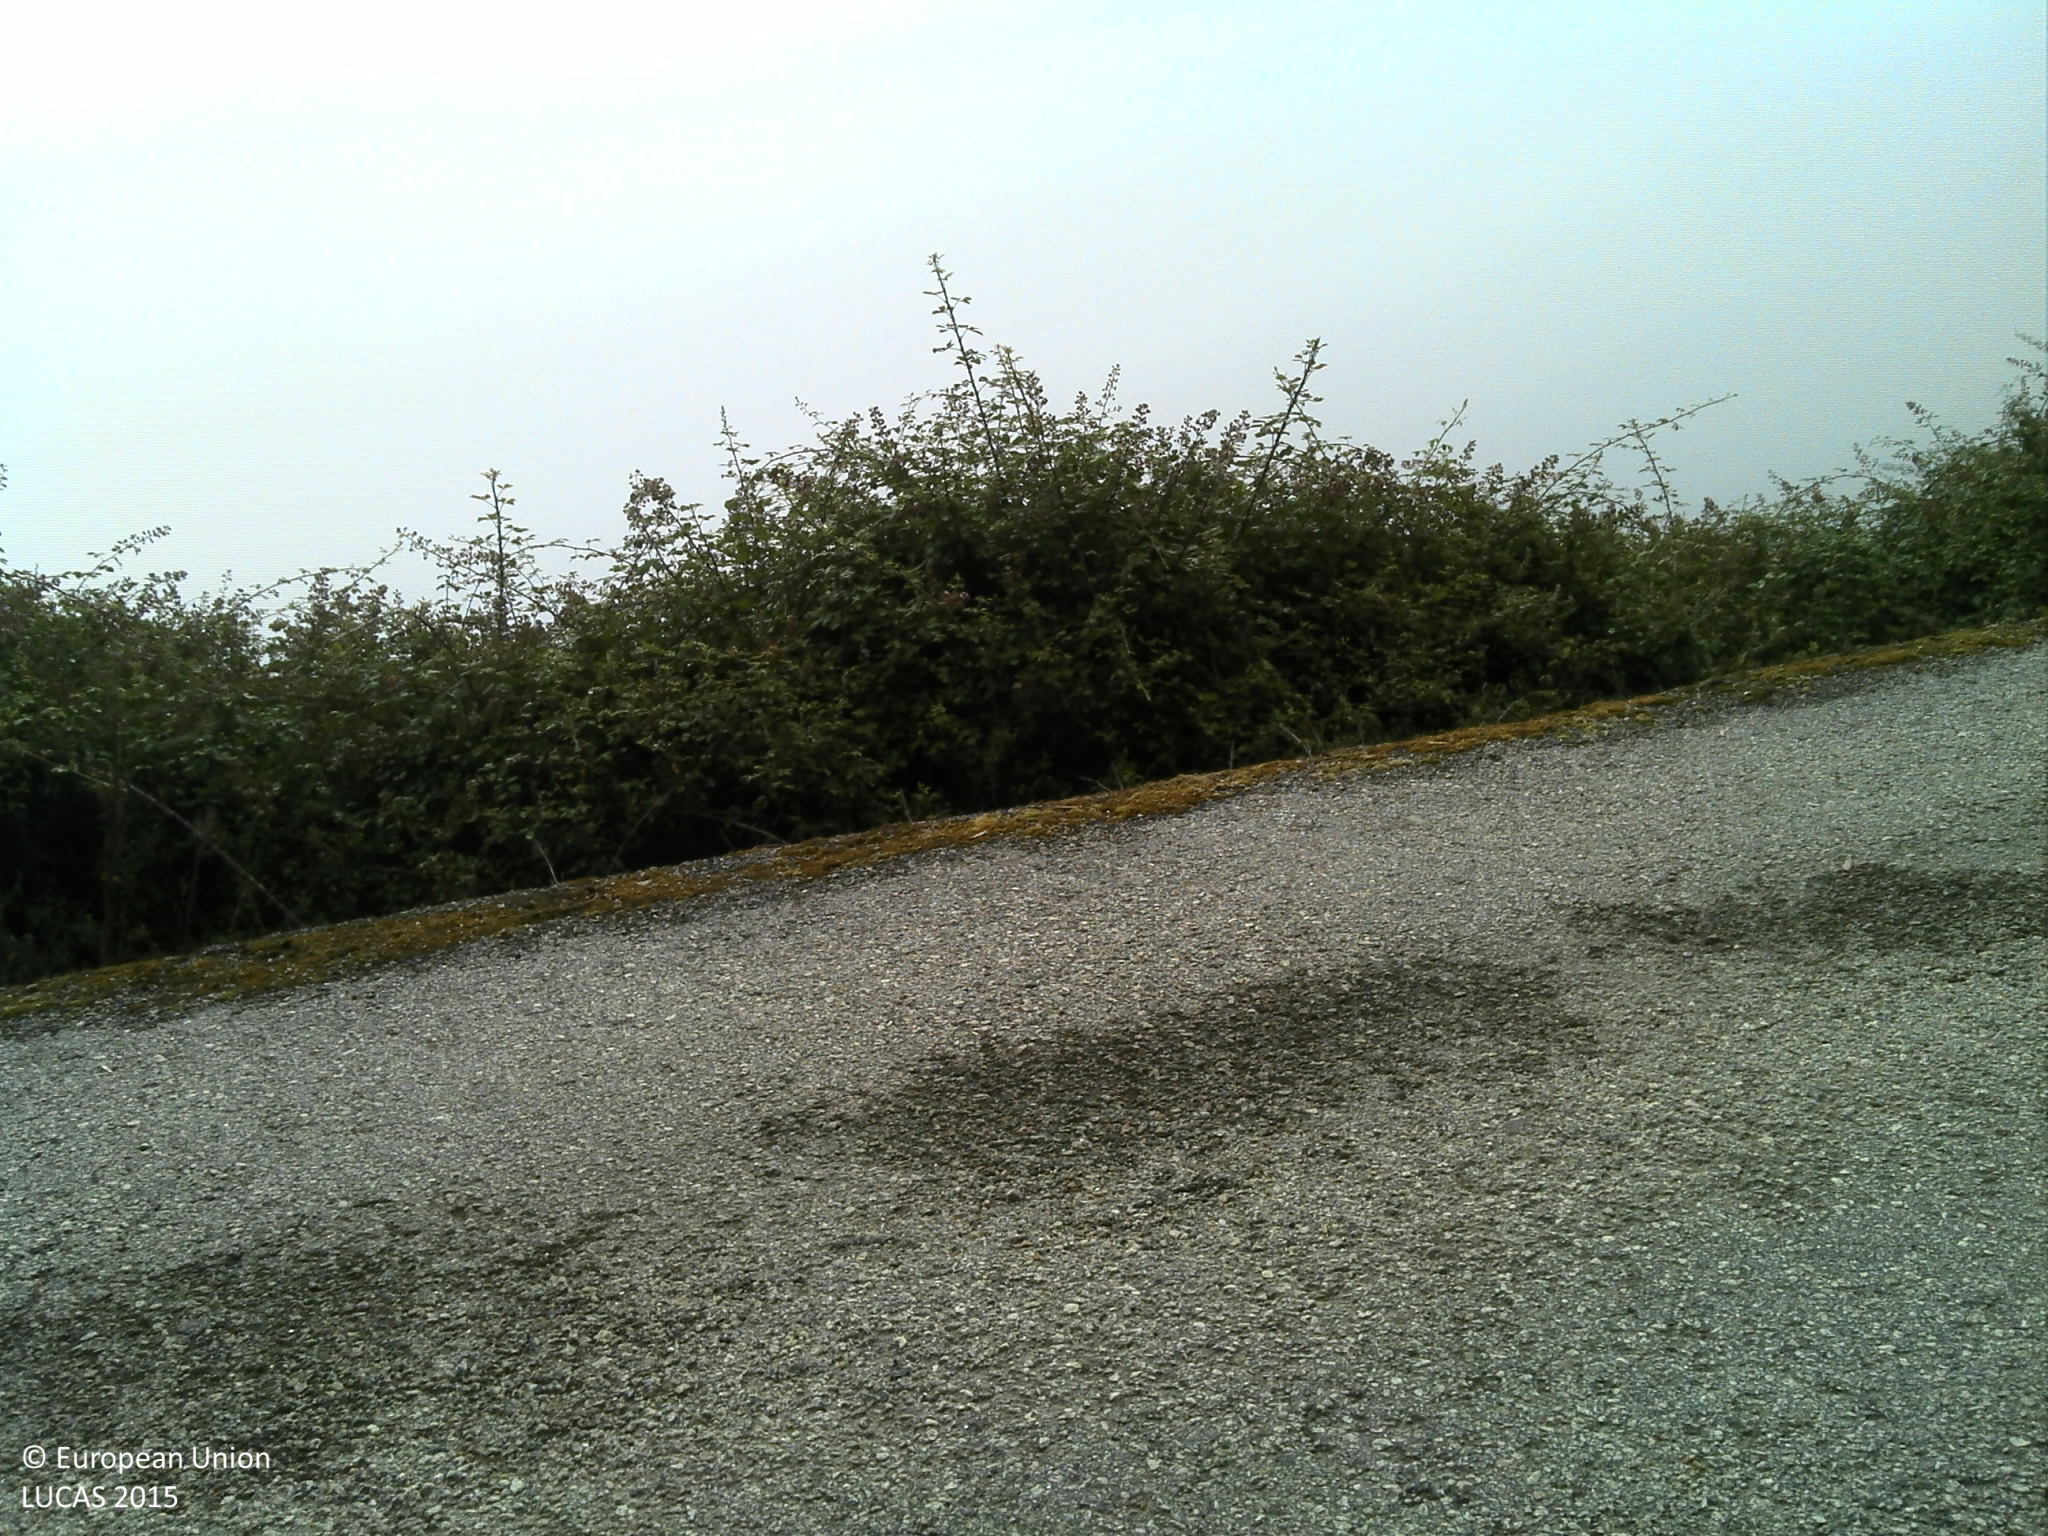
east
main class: Cropland
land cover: Olive groves
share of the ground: < 10 %
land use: Agriculture (excluding fallow land and kitchen gardens)
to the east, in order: Olive groves; Paved roads, cycling and walking lanes; Shrubland with sparse tree cover; Grass margins; Paved roads, cycling and walking lanes; Dry stone walls; Broadleaved woodland; Vineyards; Olive groves; Dry stone walls; Vineyards; Broadleaved woodland; Electric lines; Broadleaved woodland; Pine dominated mixed woodland; Broadleaved woodland; Dry stone walls; Broadleaved woodland; Dry stone walls; Broadleaved woodland
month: June
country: PT
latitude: 41.1220
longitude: -7.5719
